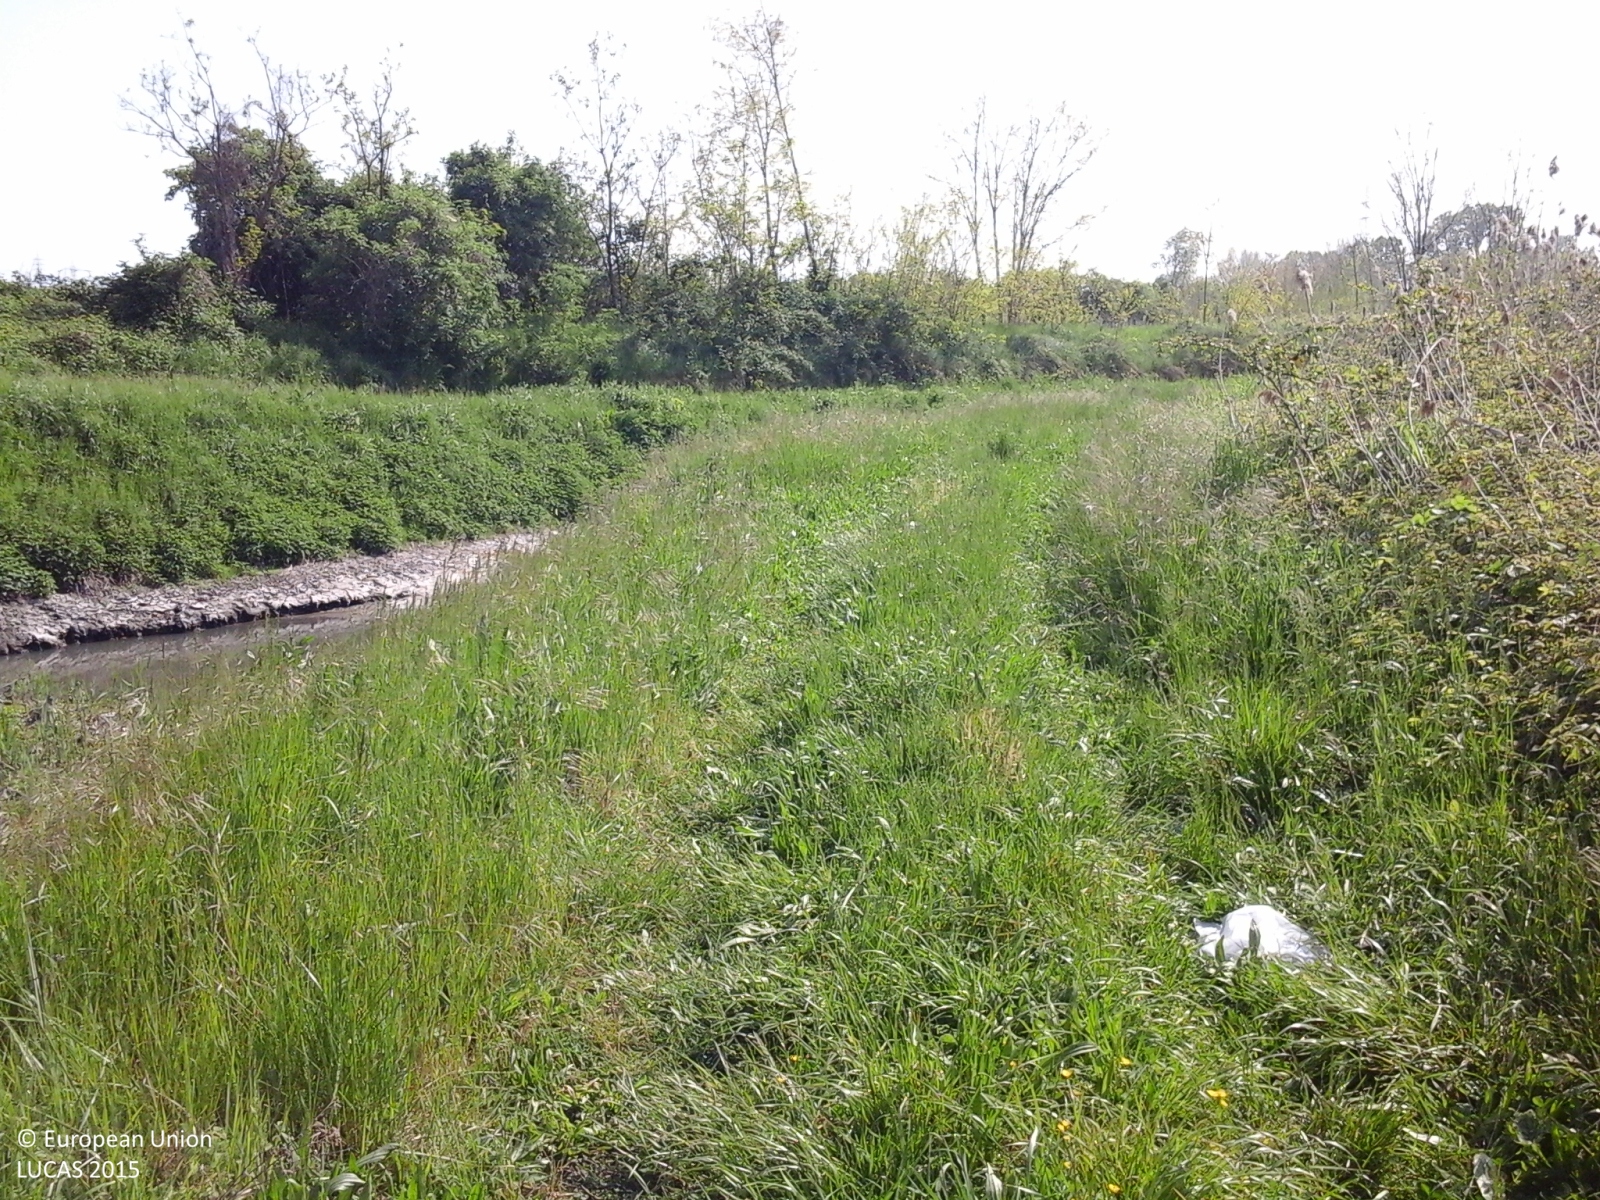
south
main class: Artificial land
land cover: Non built-up linear features
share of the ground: > 75 %
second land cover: Grassland without tree/shrub cover
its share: > 75 %
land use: Road transport
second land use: Community services
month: April
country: IT
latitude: 45.4453
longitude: 12.2083
